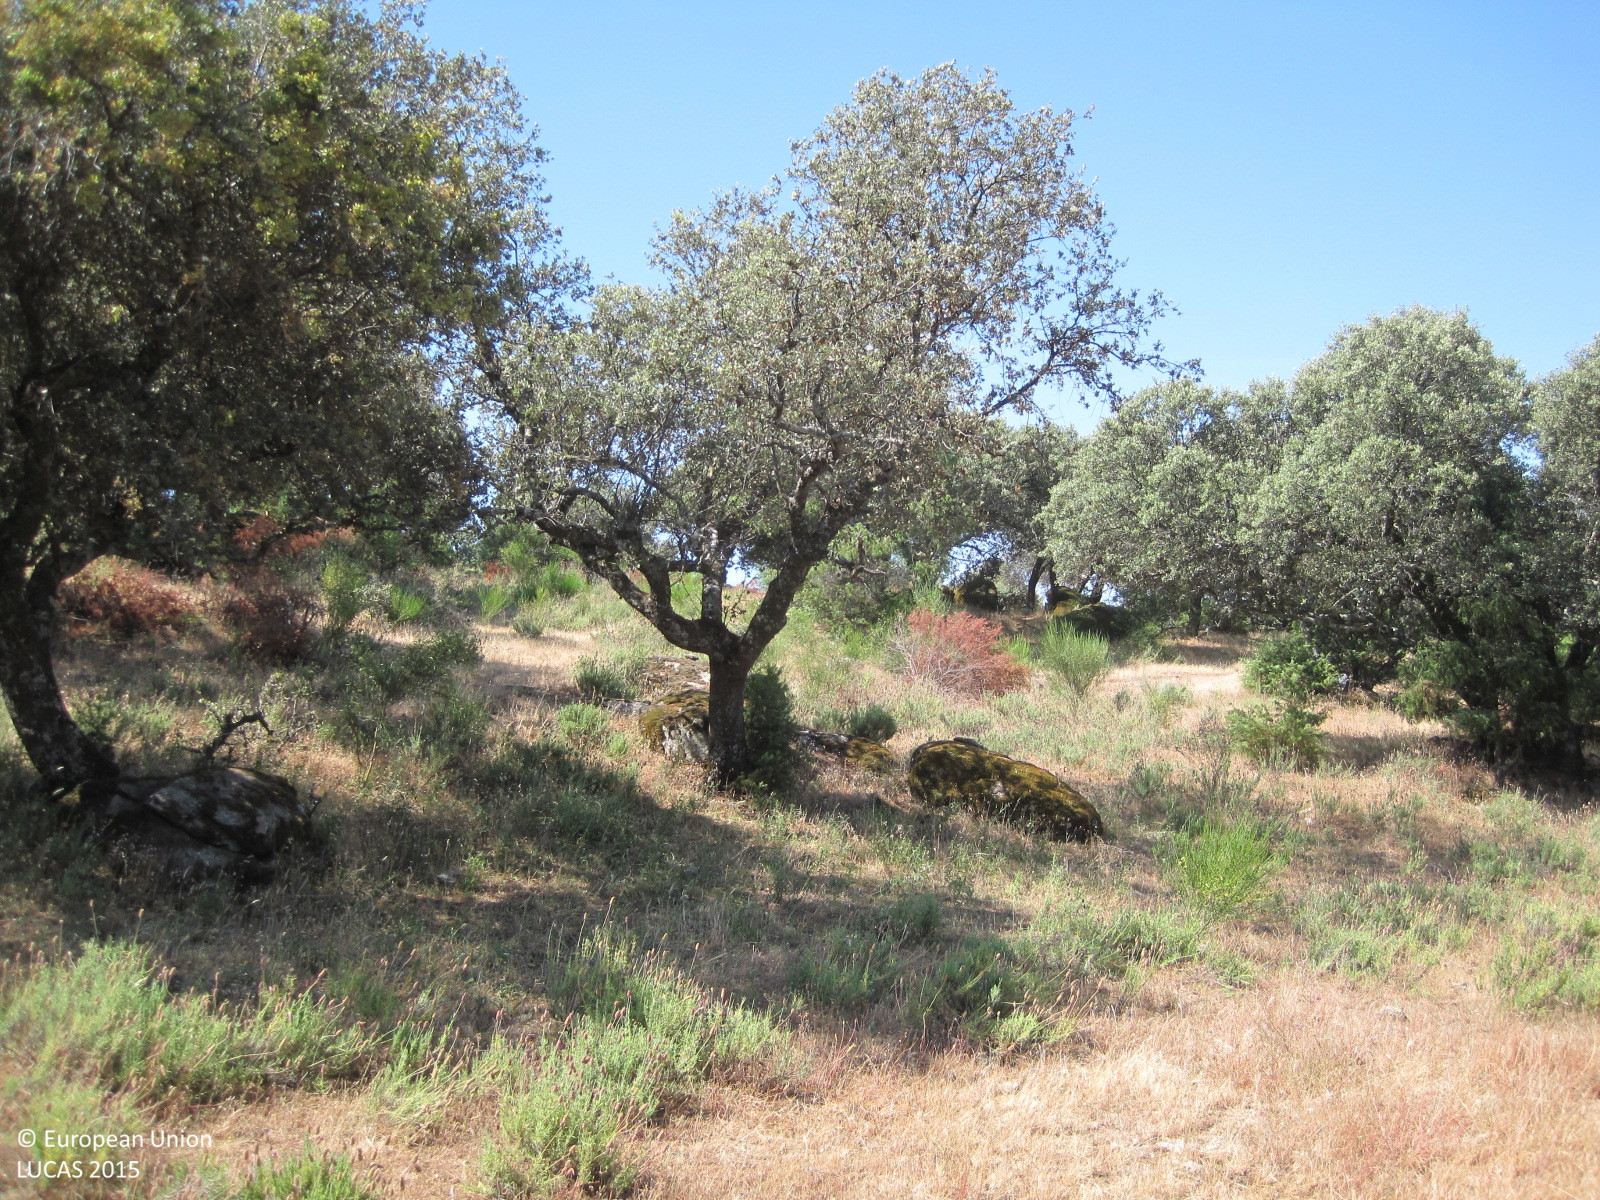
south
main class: Woodland
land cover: Broadleaved woodland
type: broadleaved evergreen forest
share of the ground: 25 - 50 %
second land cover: Grassland without tree/shrub cover
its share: > 75 %
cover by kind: herbaceous plants 55 %, broadleaved forest trees 45 %
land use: Forestry
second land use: Agriculture (excluding fallow land and kitchen gardens)
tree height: < 5 m
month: June
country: ES
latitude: 40.0971
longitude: -4.7698
